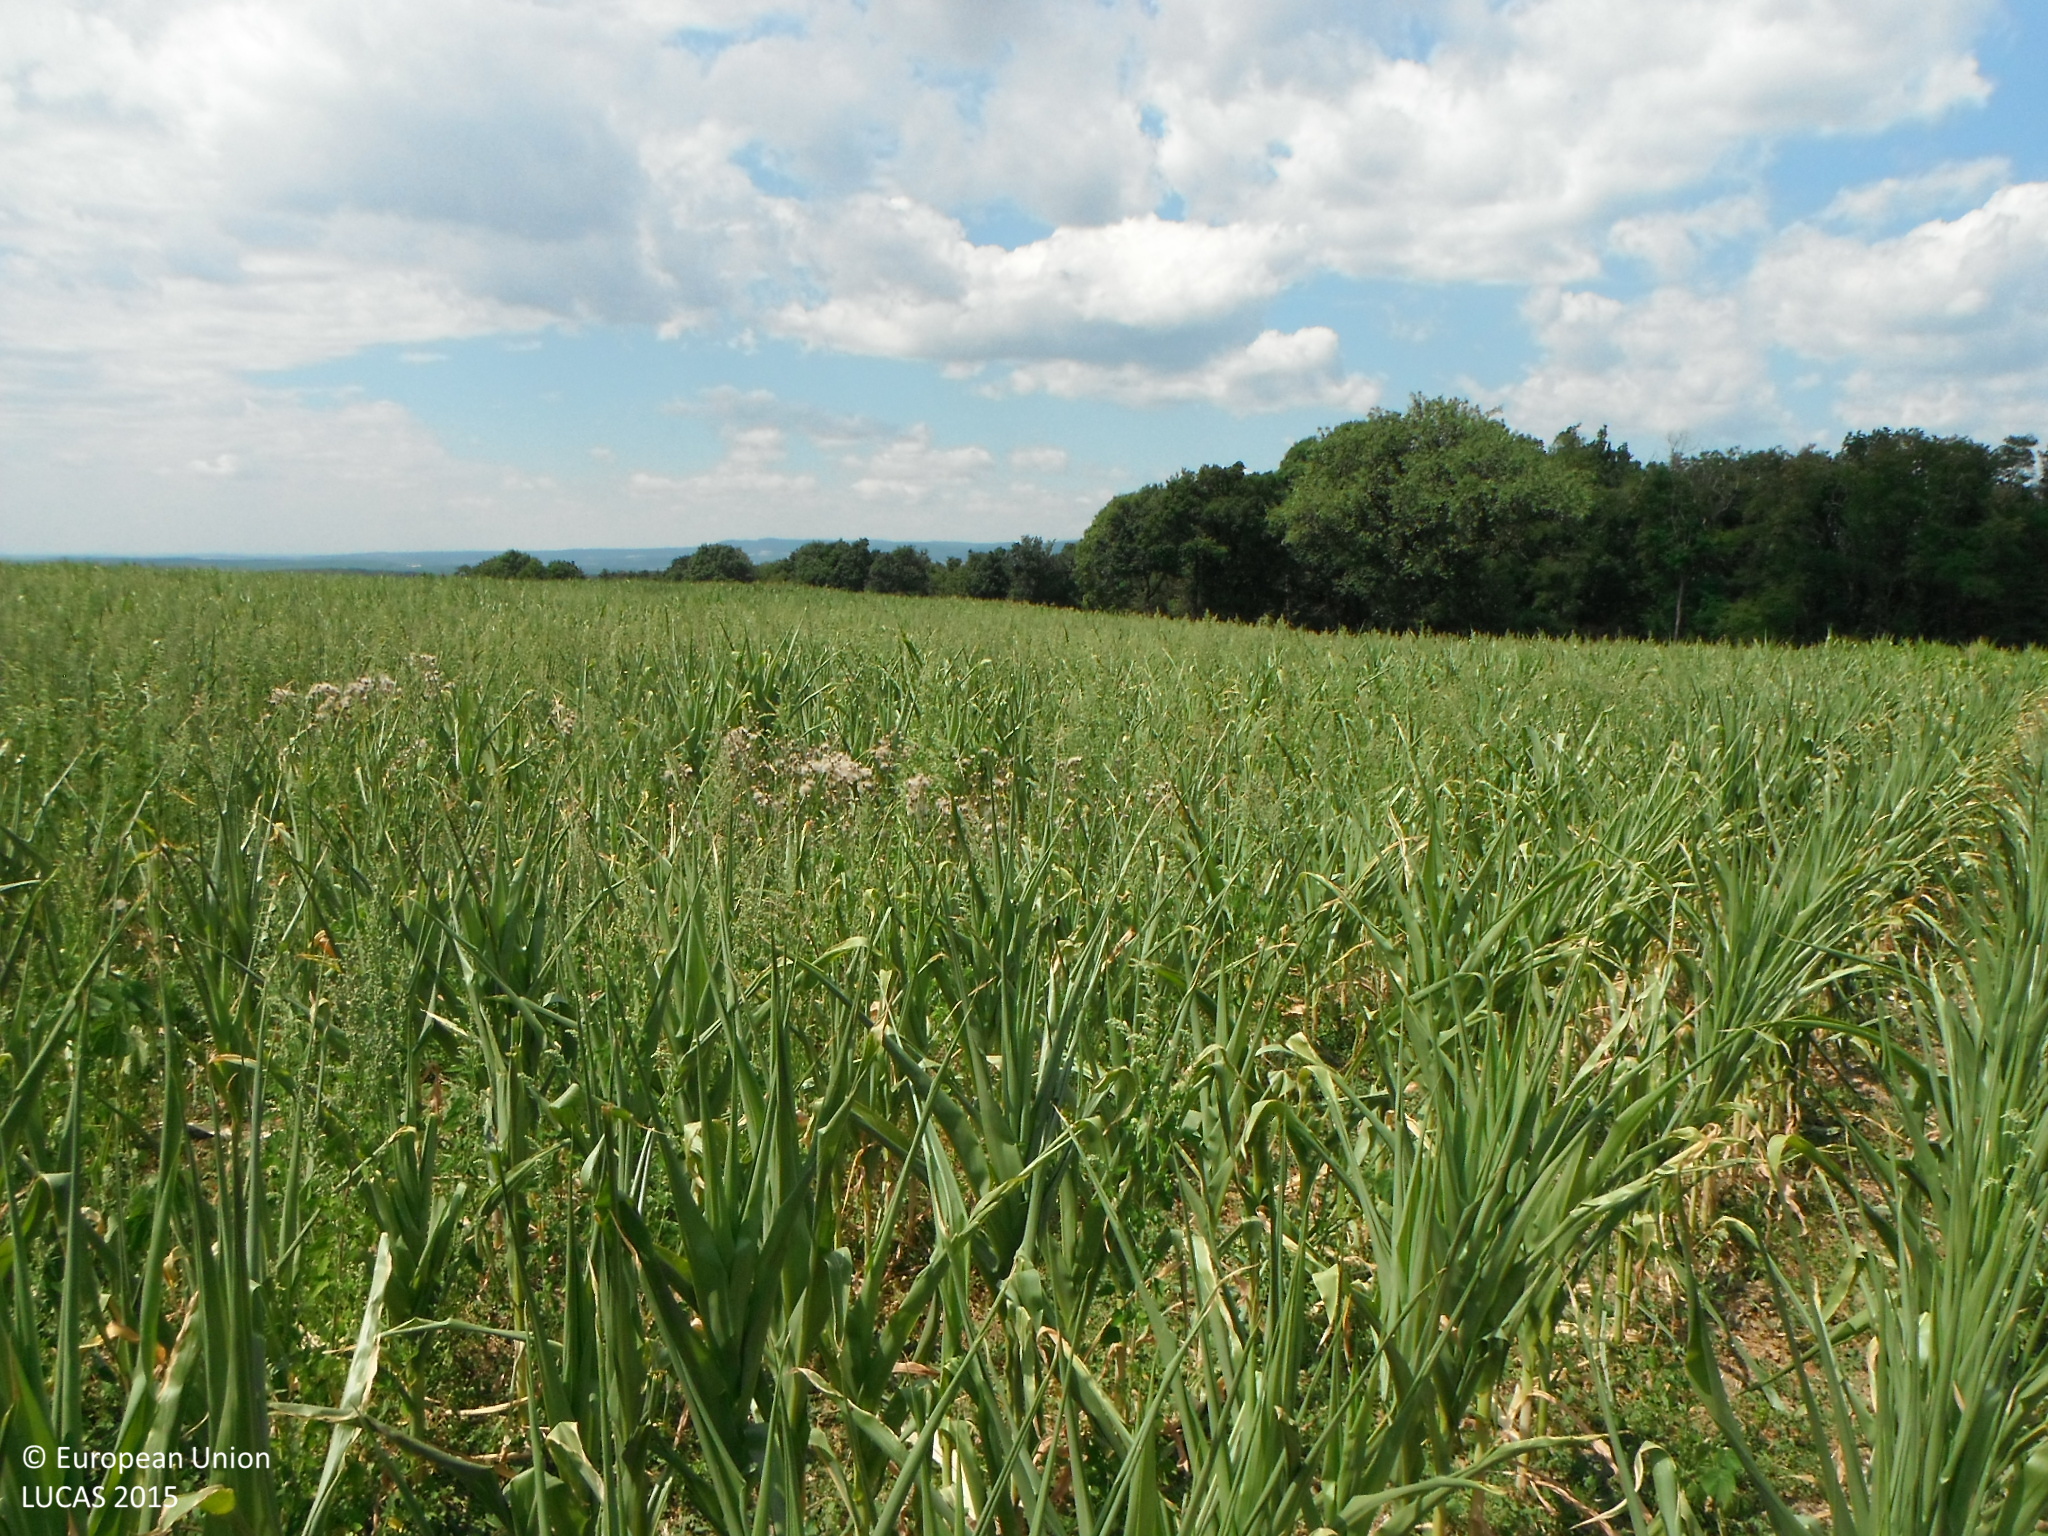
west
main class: Cropland
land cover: Maize
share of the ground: > 75 %
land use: Agriculture (excluding fallow land and kitchen gardens)
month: July
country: SK
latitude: 48.2975
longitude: 19.1201
